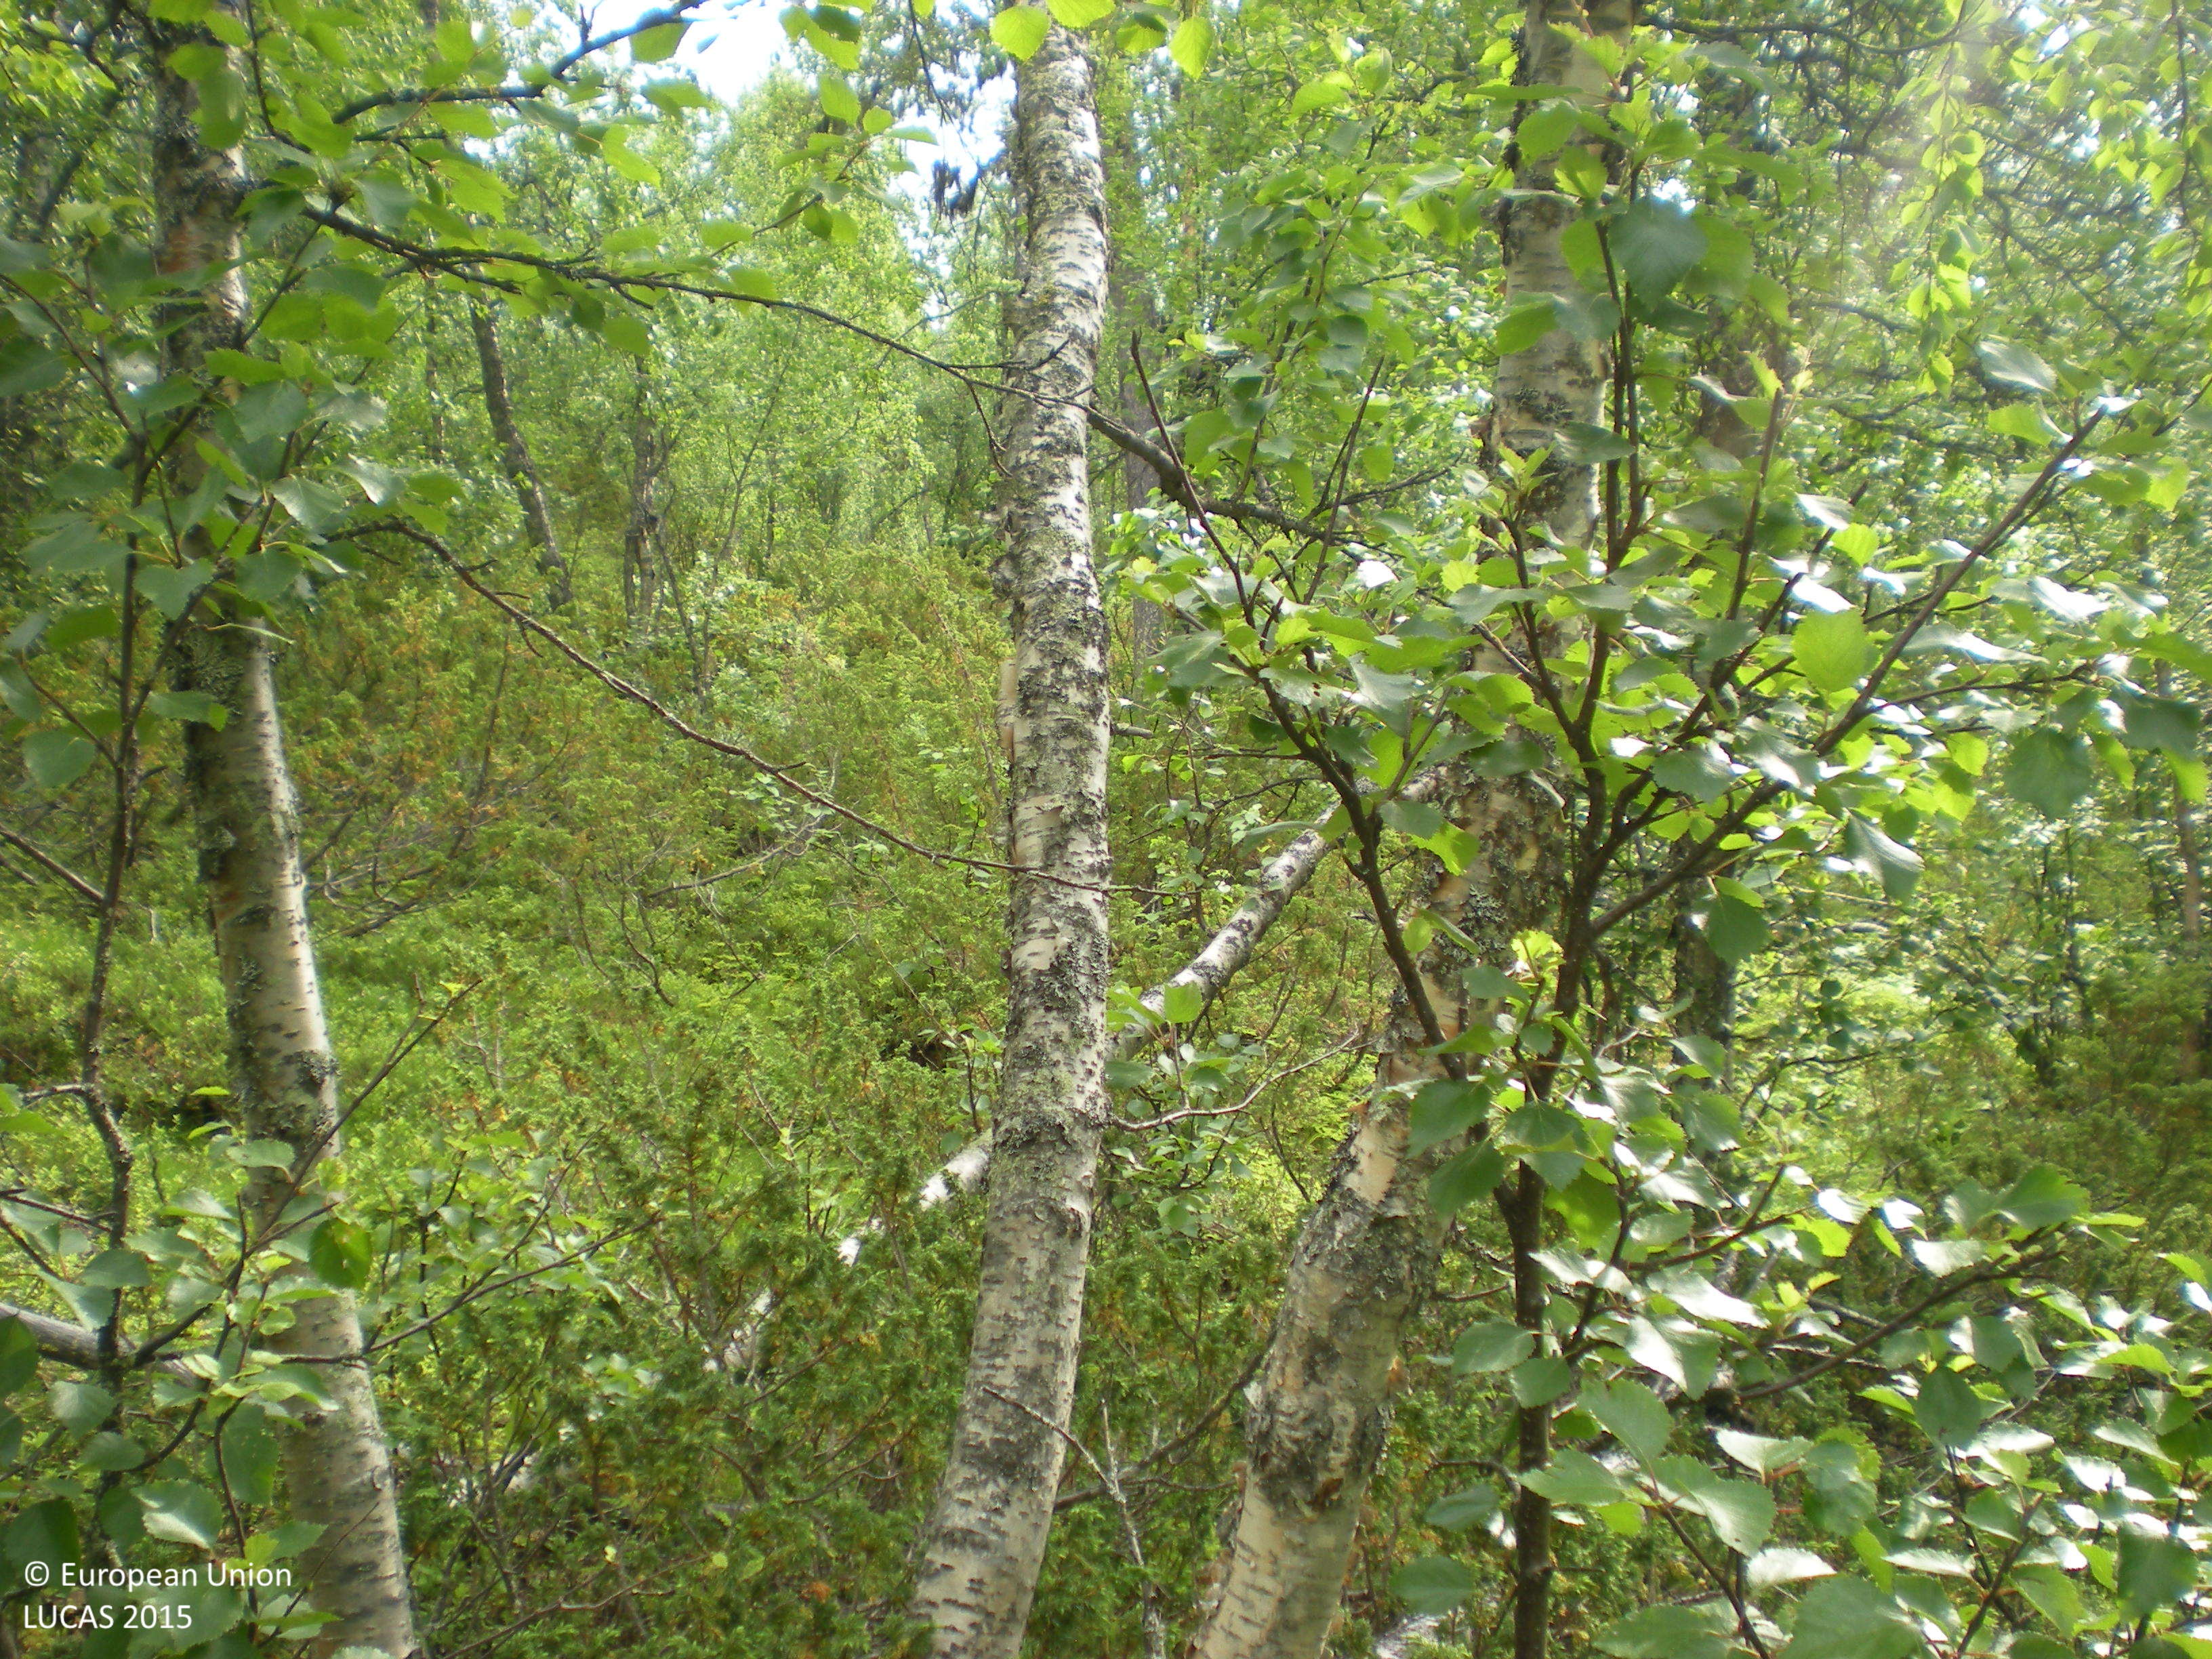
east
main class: Woodland
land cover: Broadleaved woodland
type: boreal forest
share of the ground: 50 - 75 %
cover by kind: broadleaved forest trees 70 %, shrubs 15 %, herbaceous plants 10 %, lichens and mosses 5 %
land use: Forestry
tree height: > 5 m
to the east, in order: Broadleaved woodland; Pine dominated mixed woodland
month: August
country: SE
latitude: 66.3067
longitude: 17.1574
